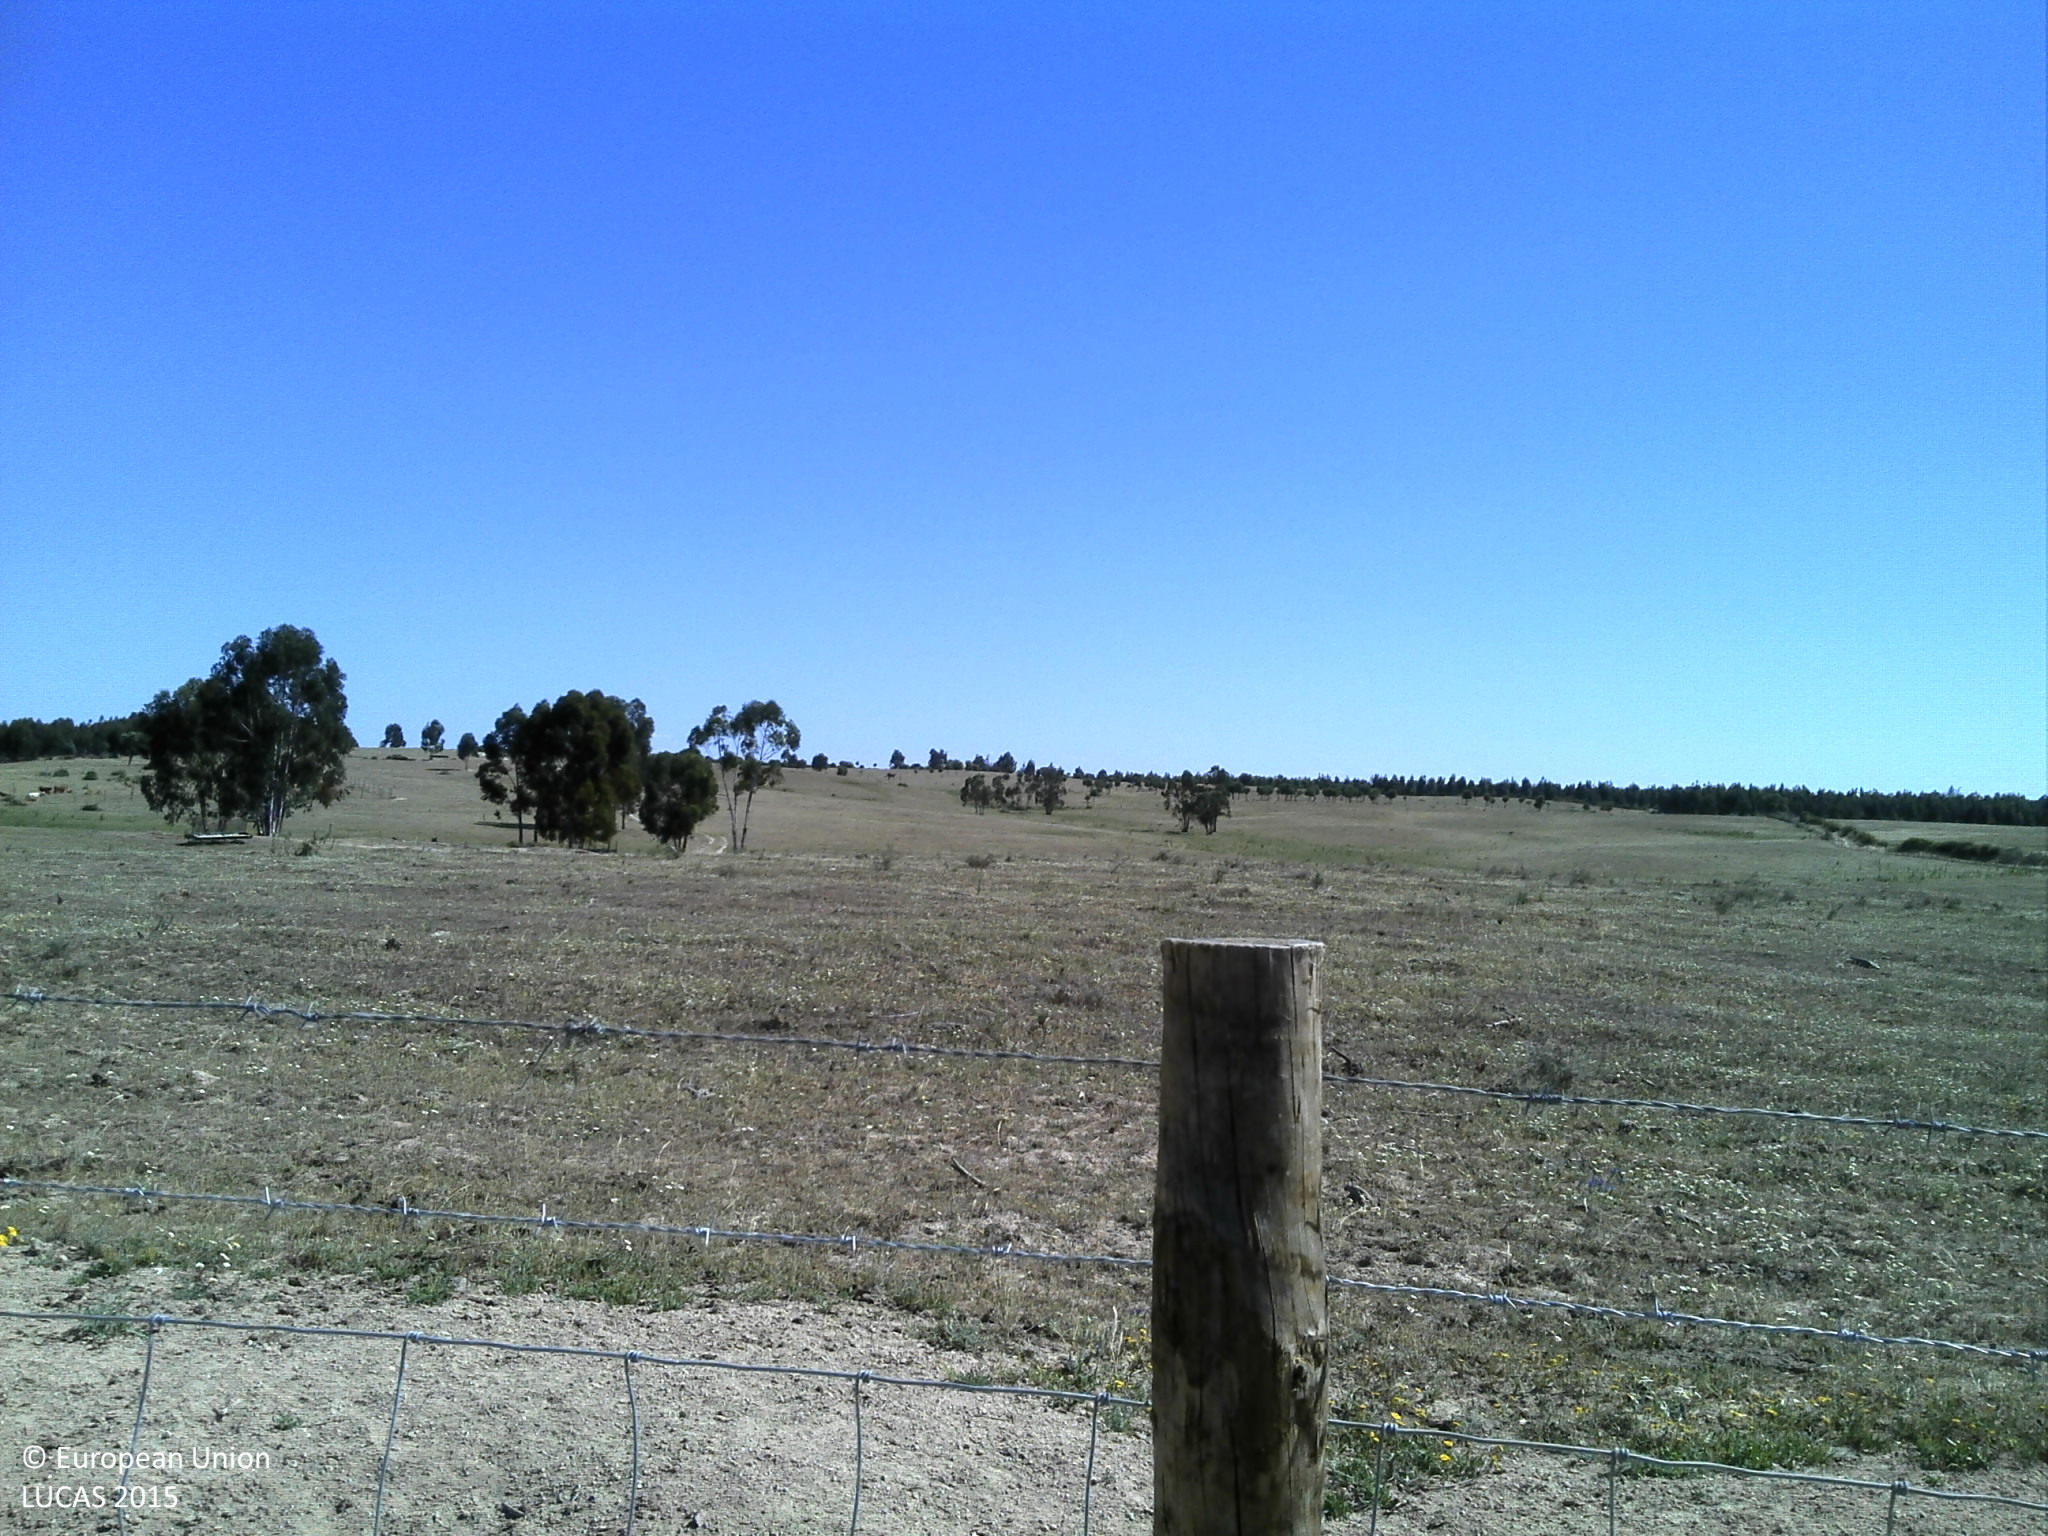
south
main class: Grassland
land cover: Grassland without tree/shrub cover
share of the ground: 25 - 50 %
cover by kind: herbaceous plants 50 %, unconsolidated bare surface 50 %
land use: Agriculture (excluding fallow land and kitchen gardens)
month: May
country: PT
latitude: 39.4027
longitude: -7.6895
